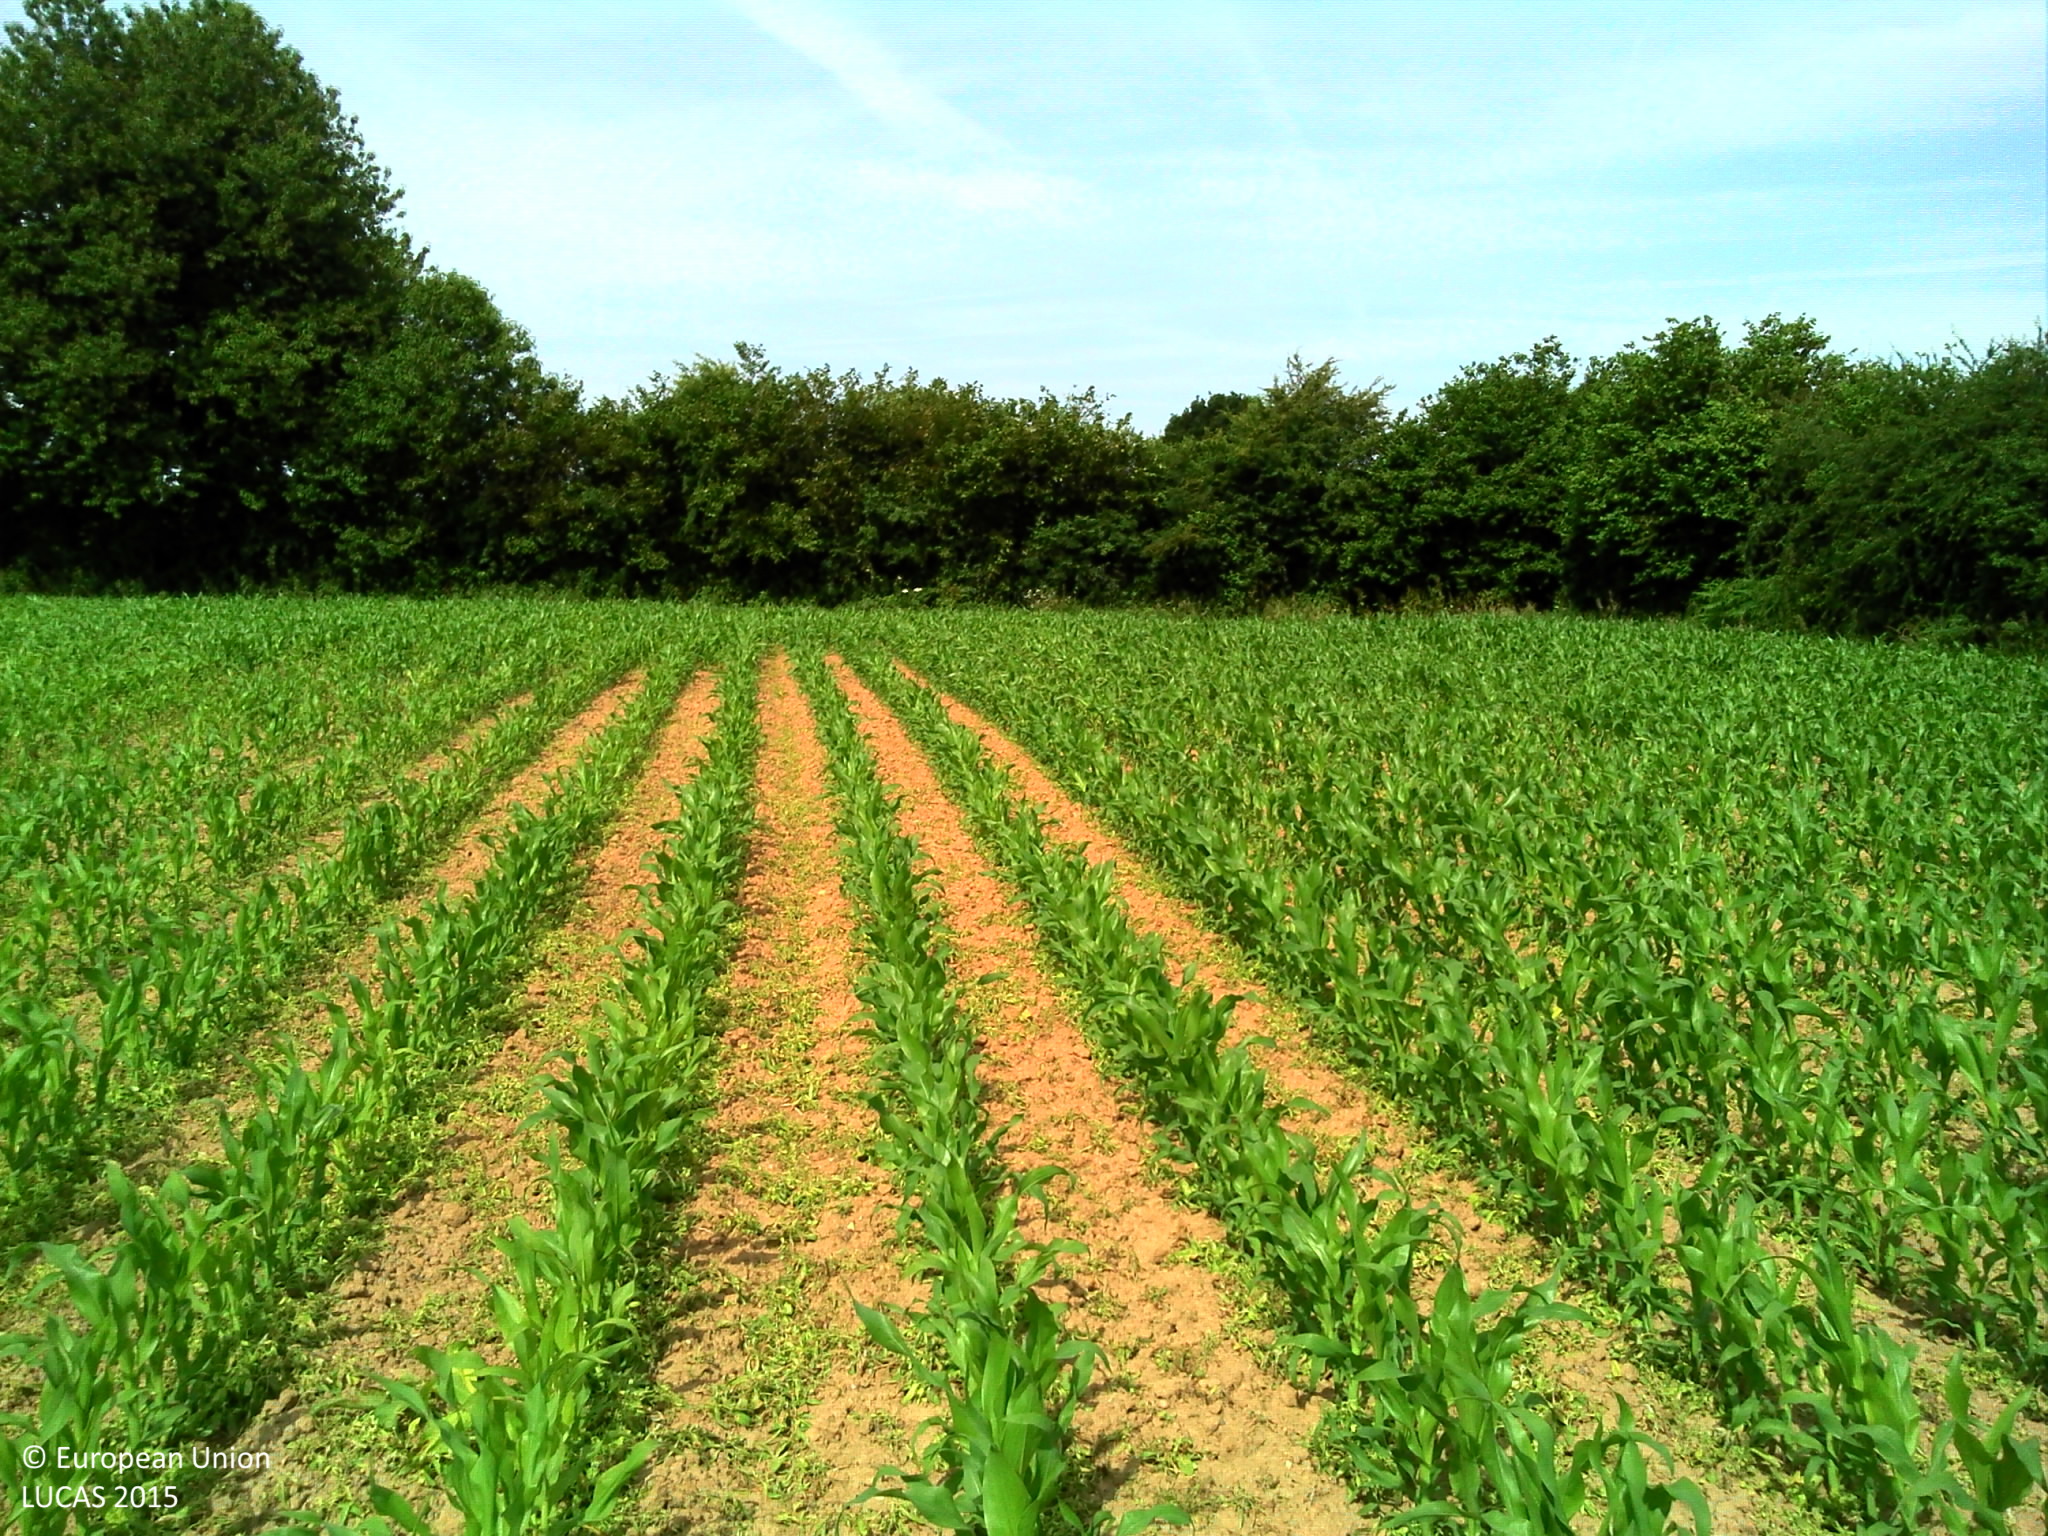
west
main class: Cropland
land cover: Maize
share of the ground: 25 - 50 %
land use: Agriculture (excluding fallow land and kitchen gardens)
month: June
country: FR
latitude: 49.2107
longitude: -1.3998
